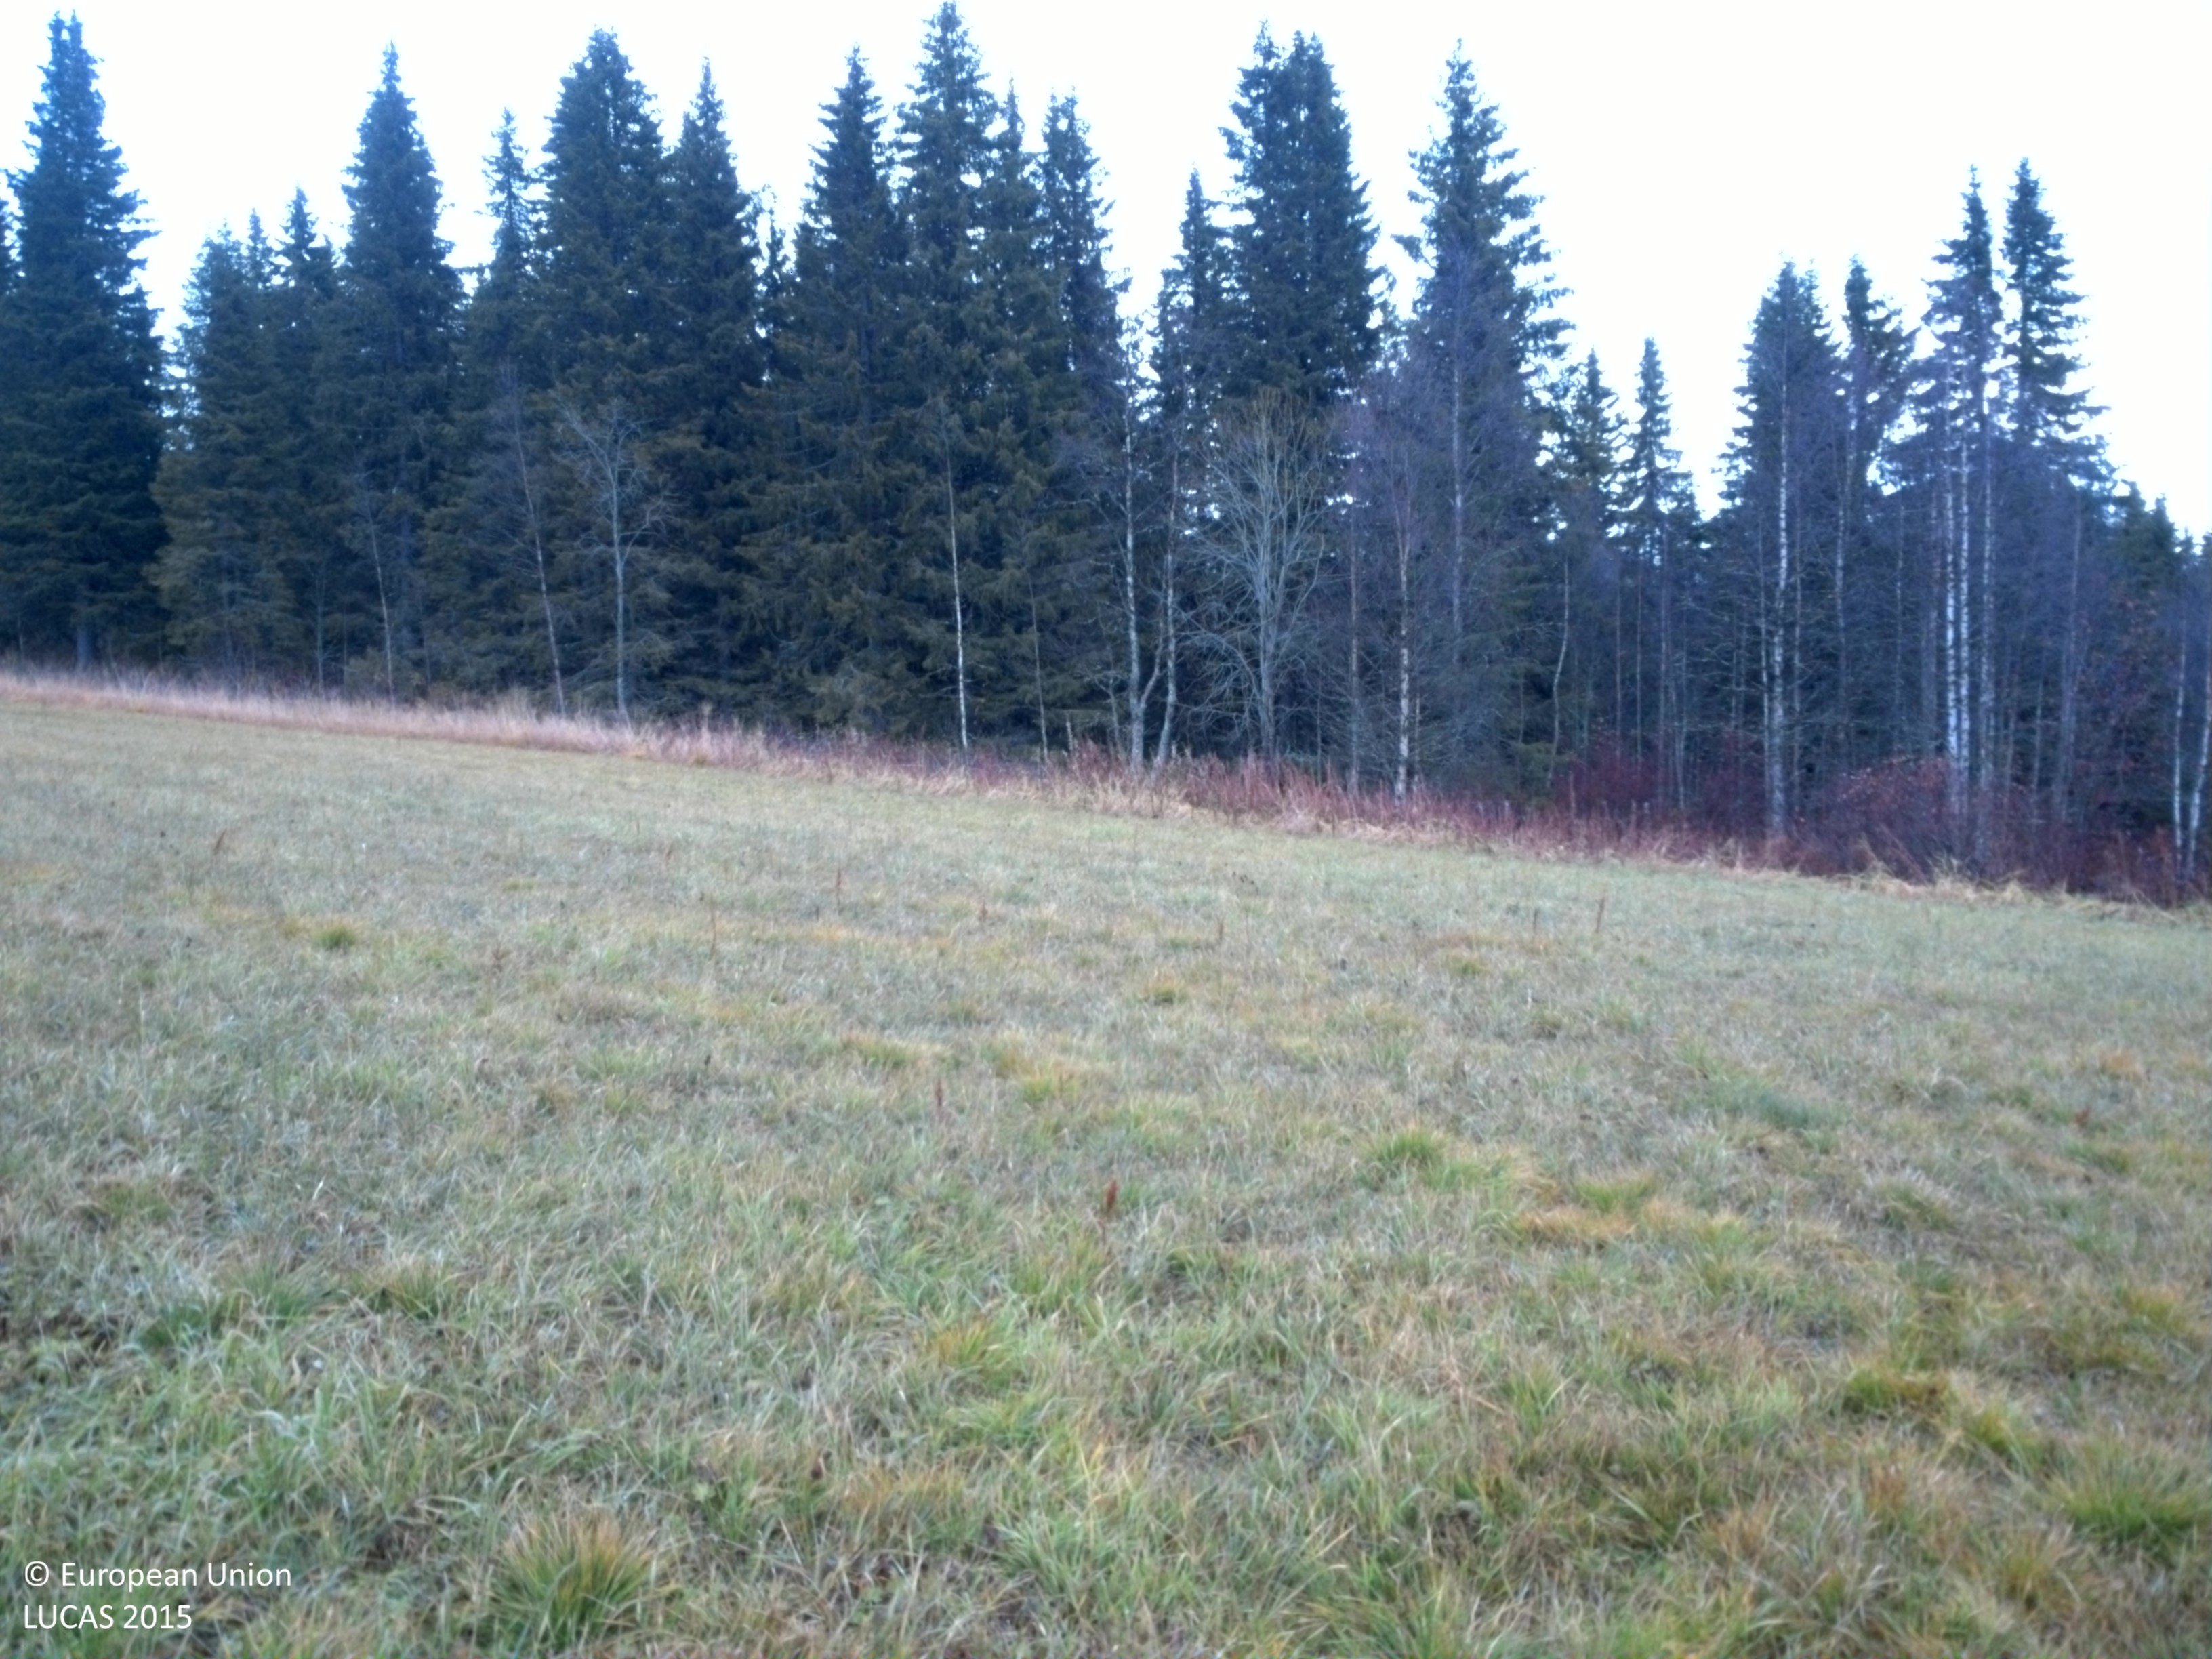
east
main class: Cropland
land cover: Temporary grasslands
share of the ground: > 75 %
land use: Agriculture (excluding fallow land and kitchen gardens)
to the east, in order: Temporary grasslands; Electric lines; Temporary grasslands; Spruce dominated mixed woodland; Spruce dominated coniferous woodland; Ditches and canals; Groves; Tracks; Broadleaved woodland; Spruce dominated mixed woodland; Grassland with sparse tree/shrub cover; Paved roads, cycling and walking lanes; Grass margins; Ditches and canals; Grass margins; Electric lines; Shrubland without tree cover; Tracks; Broadleaved woodland; Electric lines; Broadleaved woodland; Ditches and canals; Broadleaved woodland; Grassland with sparse tree/shrub cover; Spontaneously vegetated surfaces
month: October
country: SE
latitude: 64.5535
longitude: 17.3718
